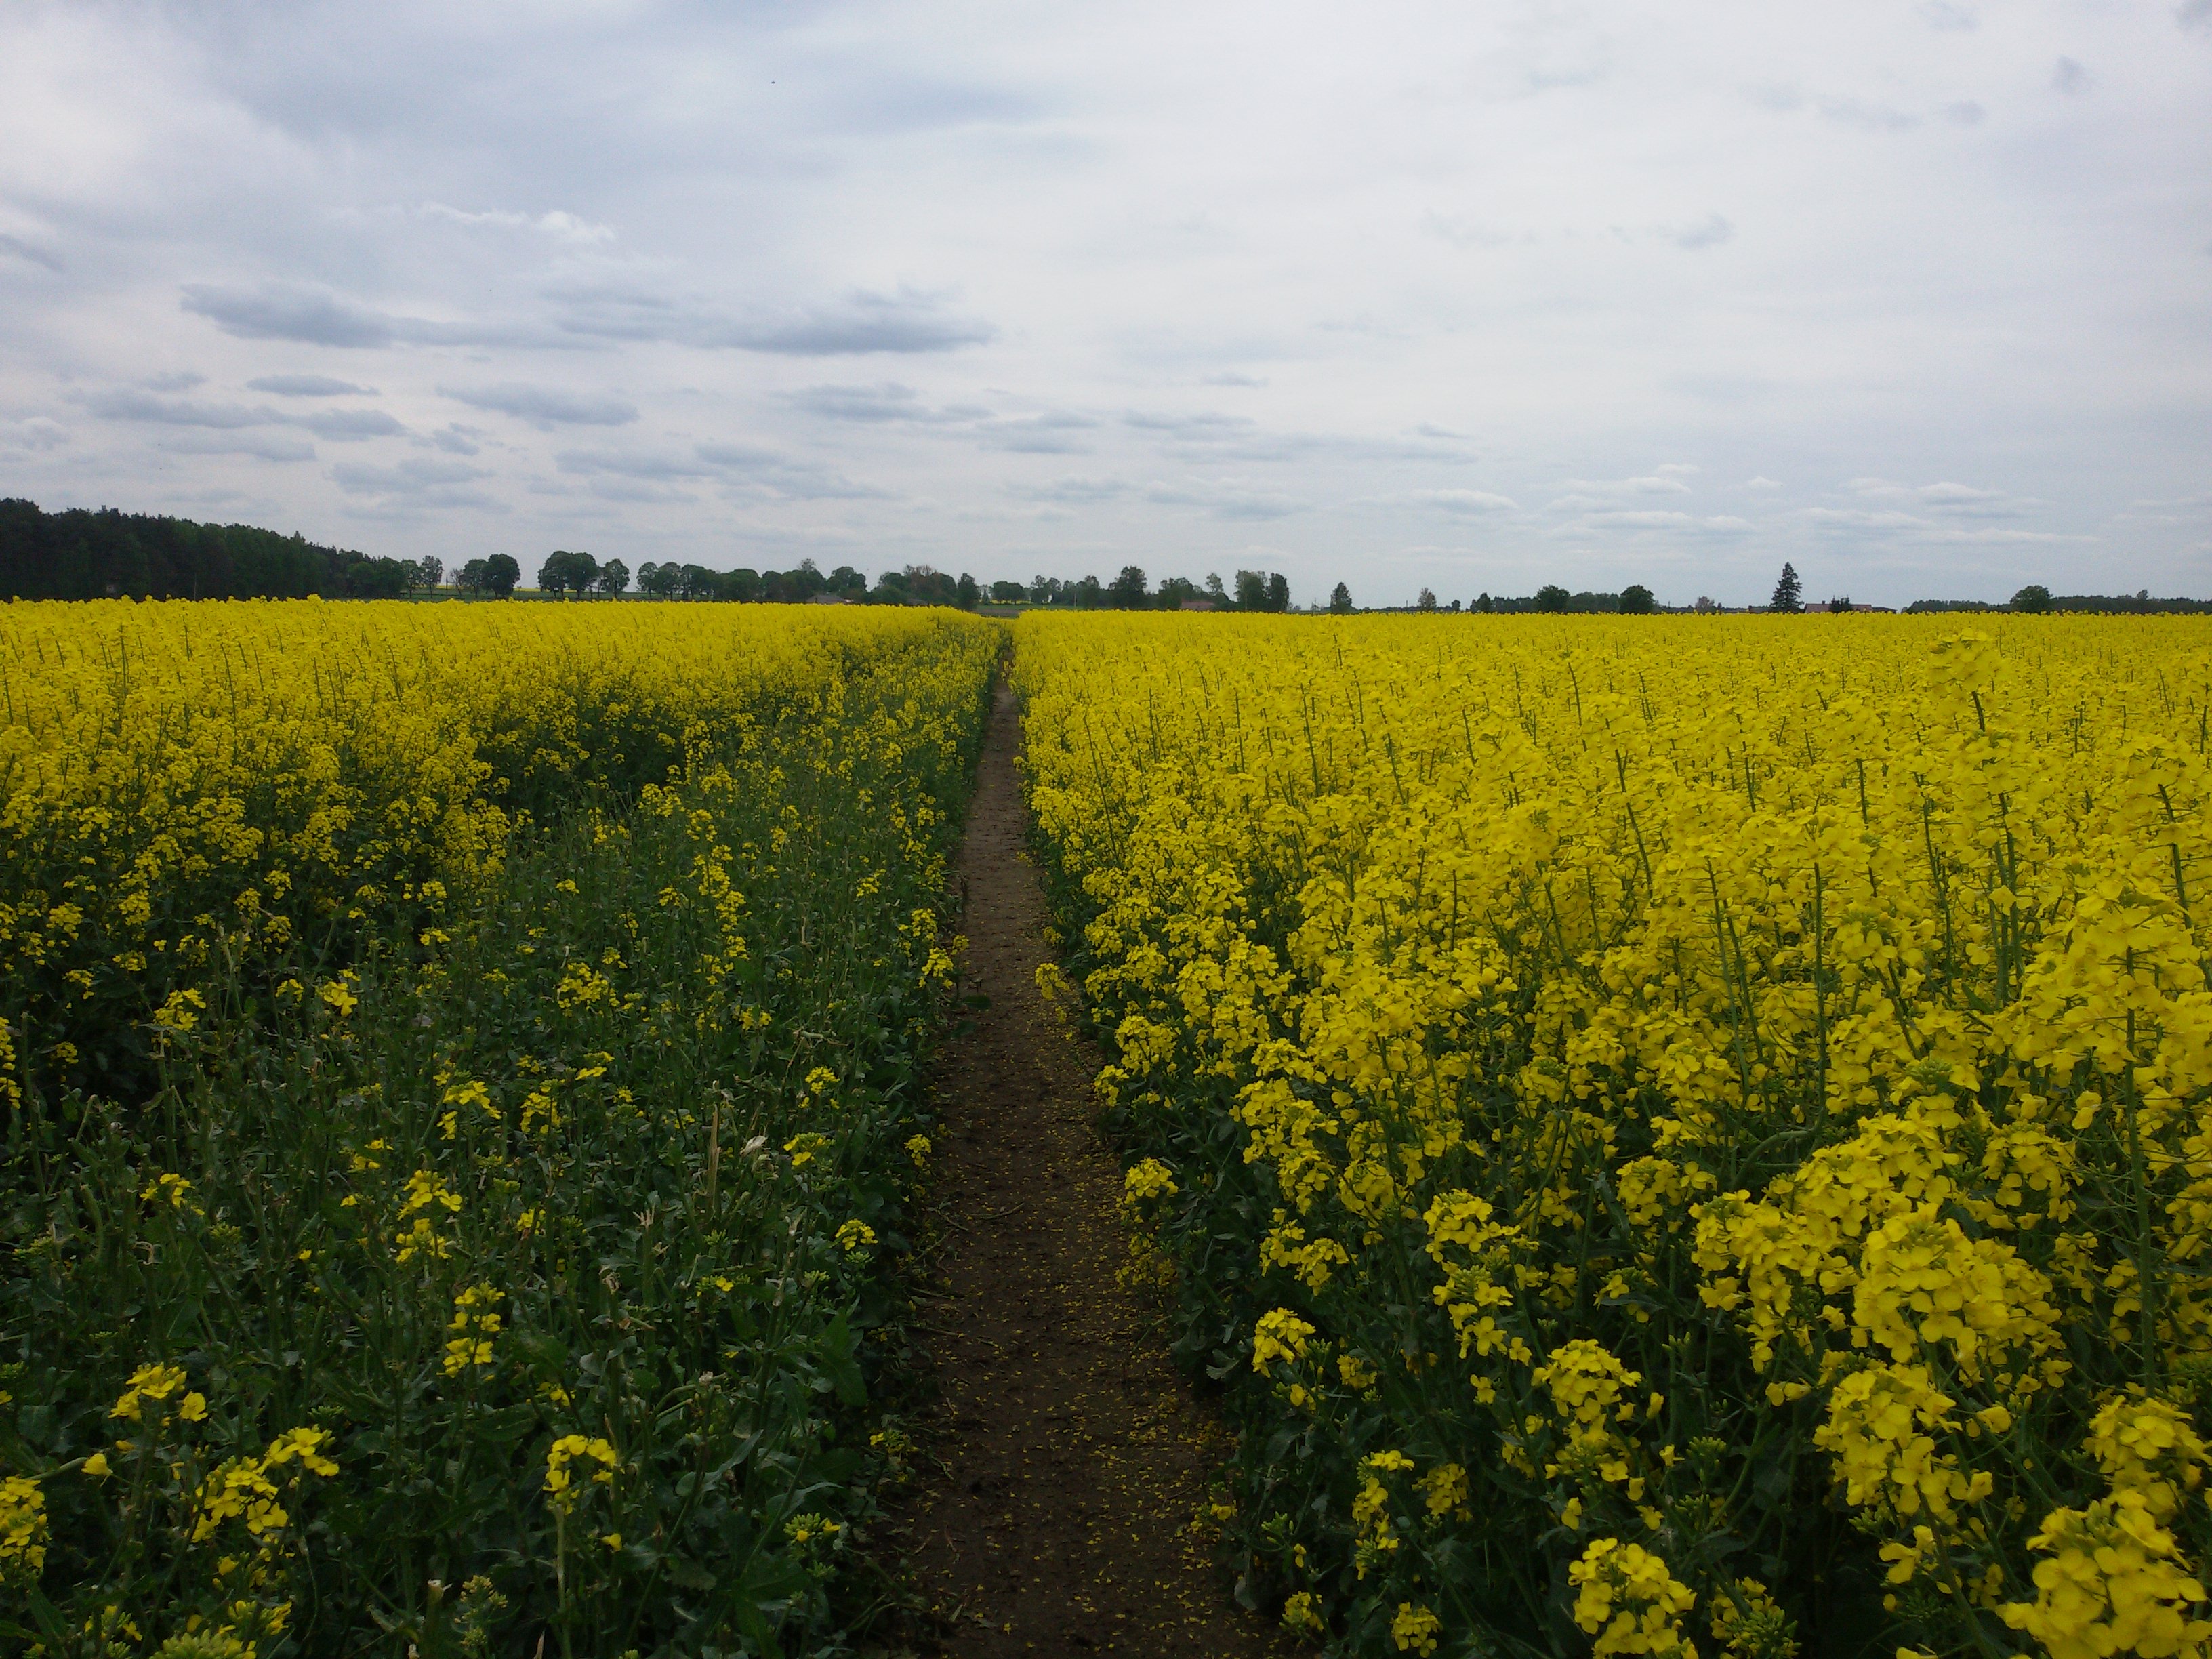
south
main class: Cropland
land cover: Rape and turnip rape
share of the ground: > 75 %
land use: Agriculture (excluding fallow land and kitchen gardens)
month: May
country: PL
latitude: 53.4818
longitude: 17.1071
